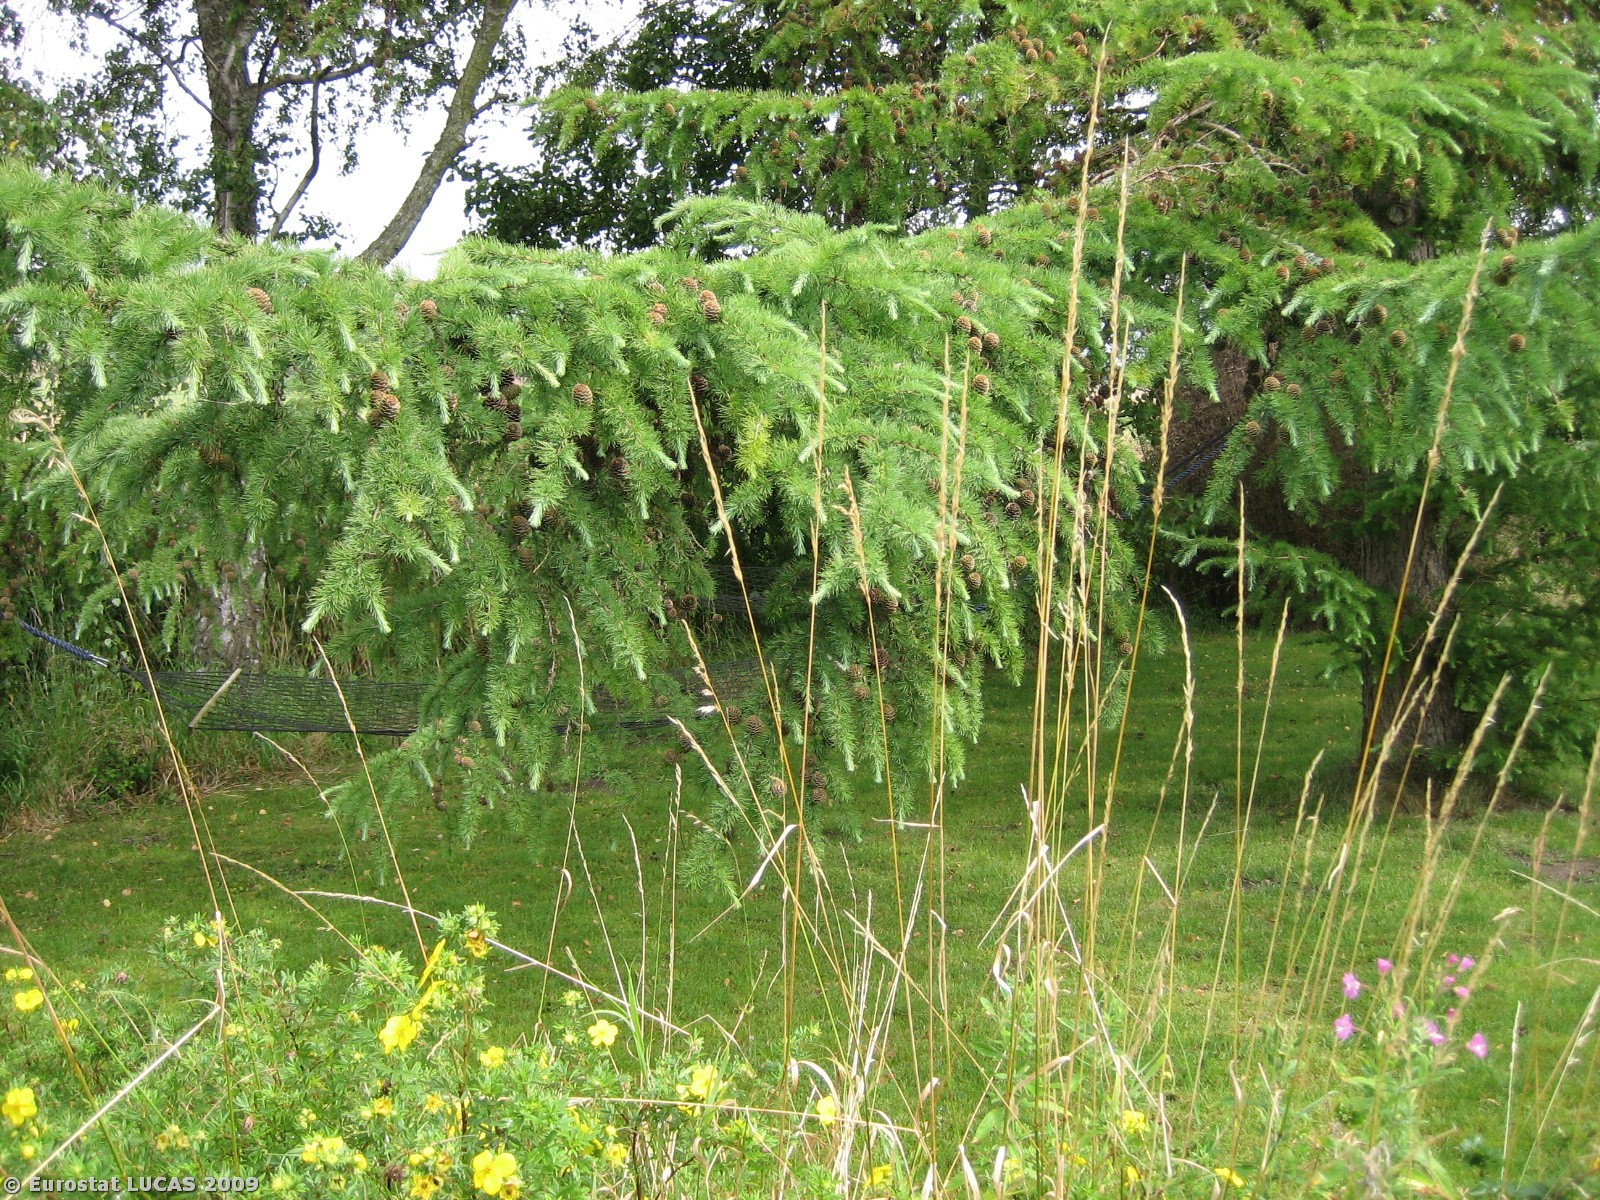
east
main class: Woodland
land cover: Broadleaved woodland
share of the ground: > 75 %
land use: Residential
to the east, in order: Broadleaved woodland; Fences; Grassland without tree/shrub cover; Fences; Grassland without tree/shrub cover; Tracks; Grassland without tree/shrub cover; Inland running water; Grassland without tree/shrub cover; Shruby margins; Bare land
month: July
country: DK
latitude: 55.3249
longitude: 9.9213
